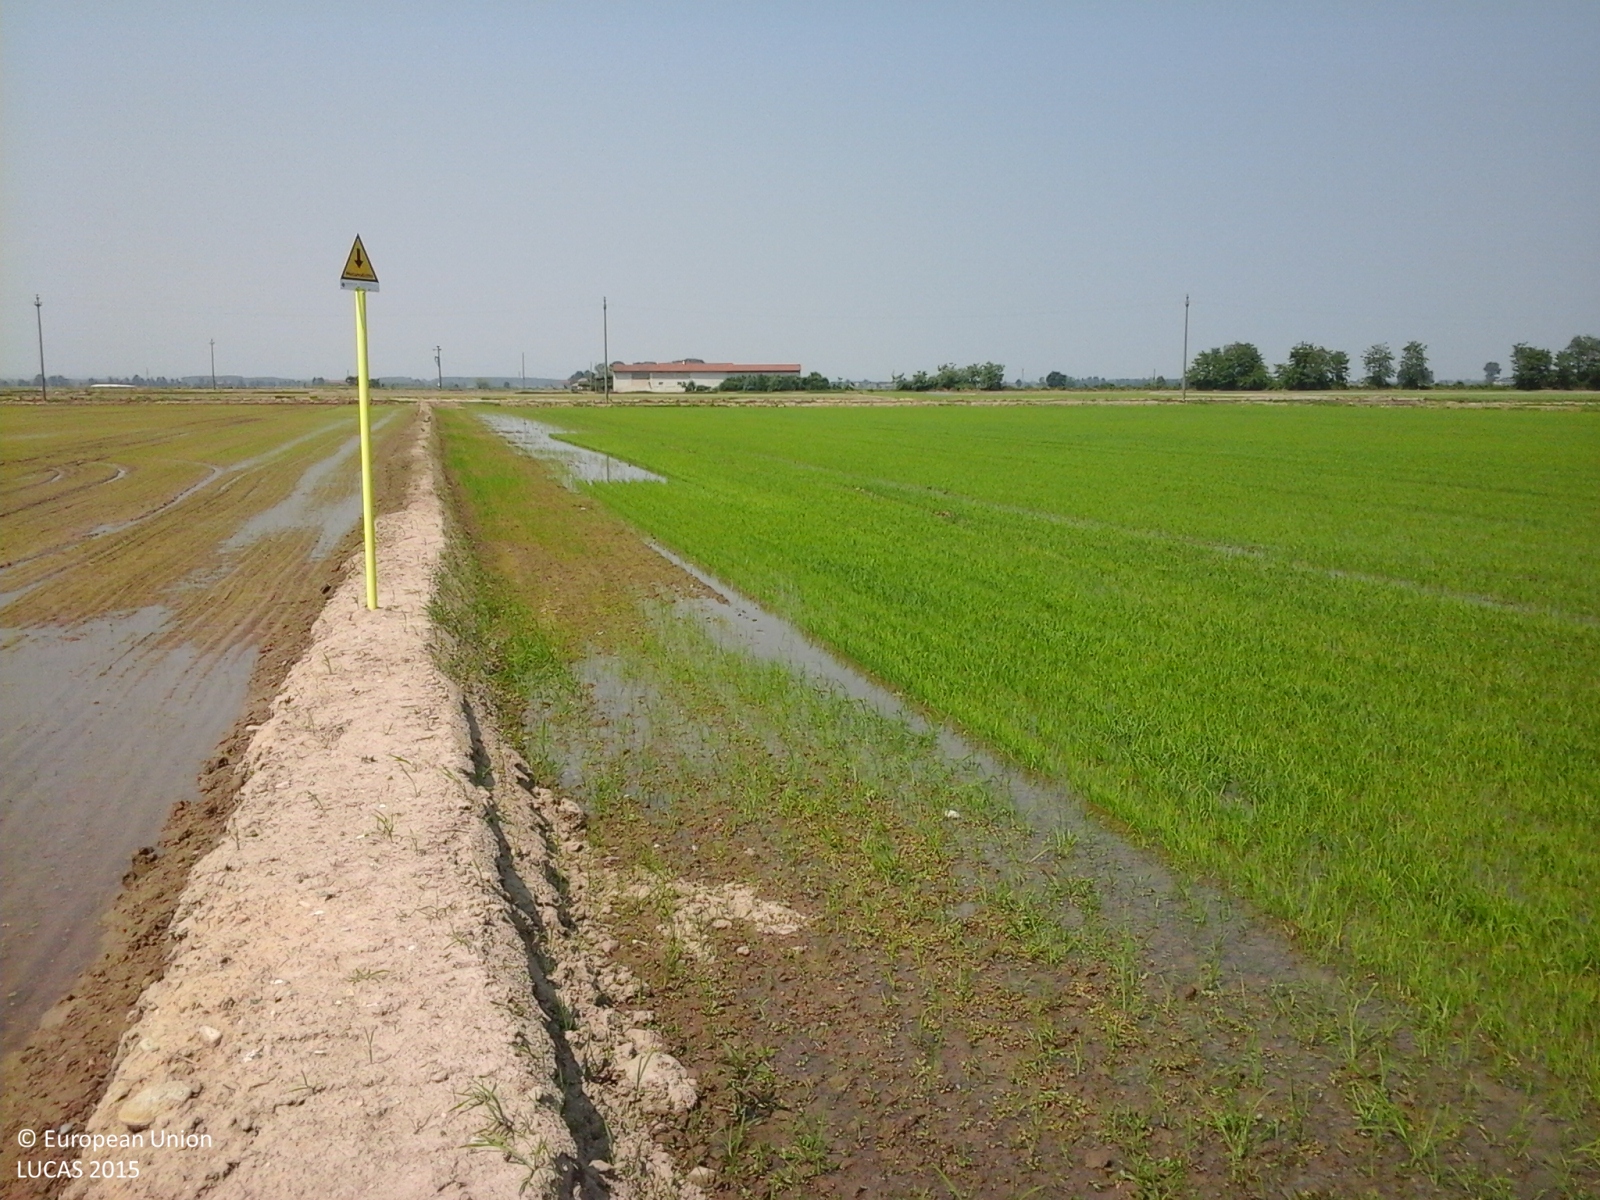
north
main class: Cropland
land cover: Rice
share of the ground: 25 - 50 %
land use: Agriculture (excluding fallow land and kitchen gardens)
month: May
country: IT
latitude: 45.3634
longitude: 8.2284
